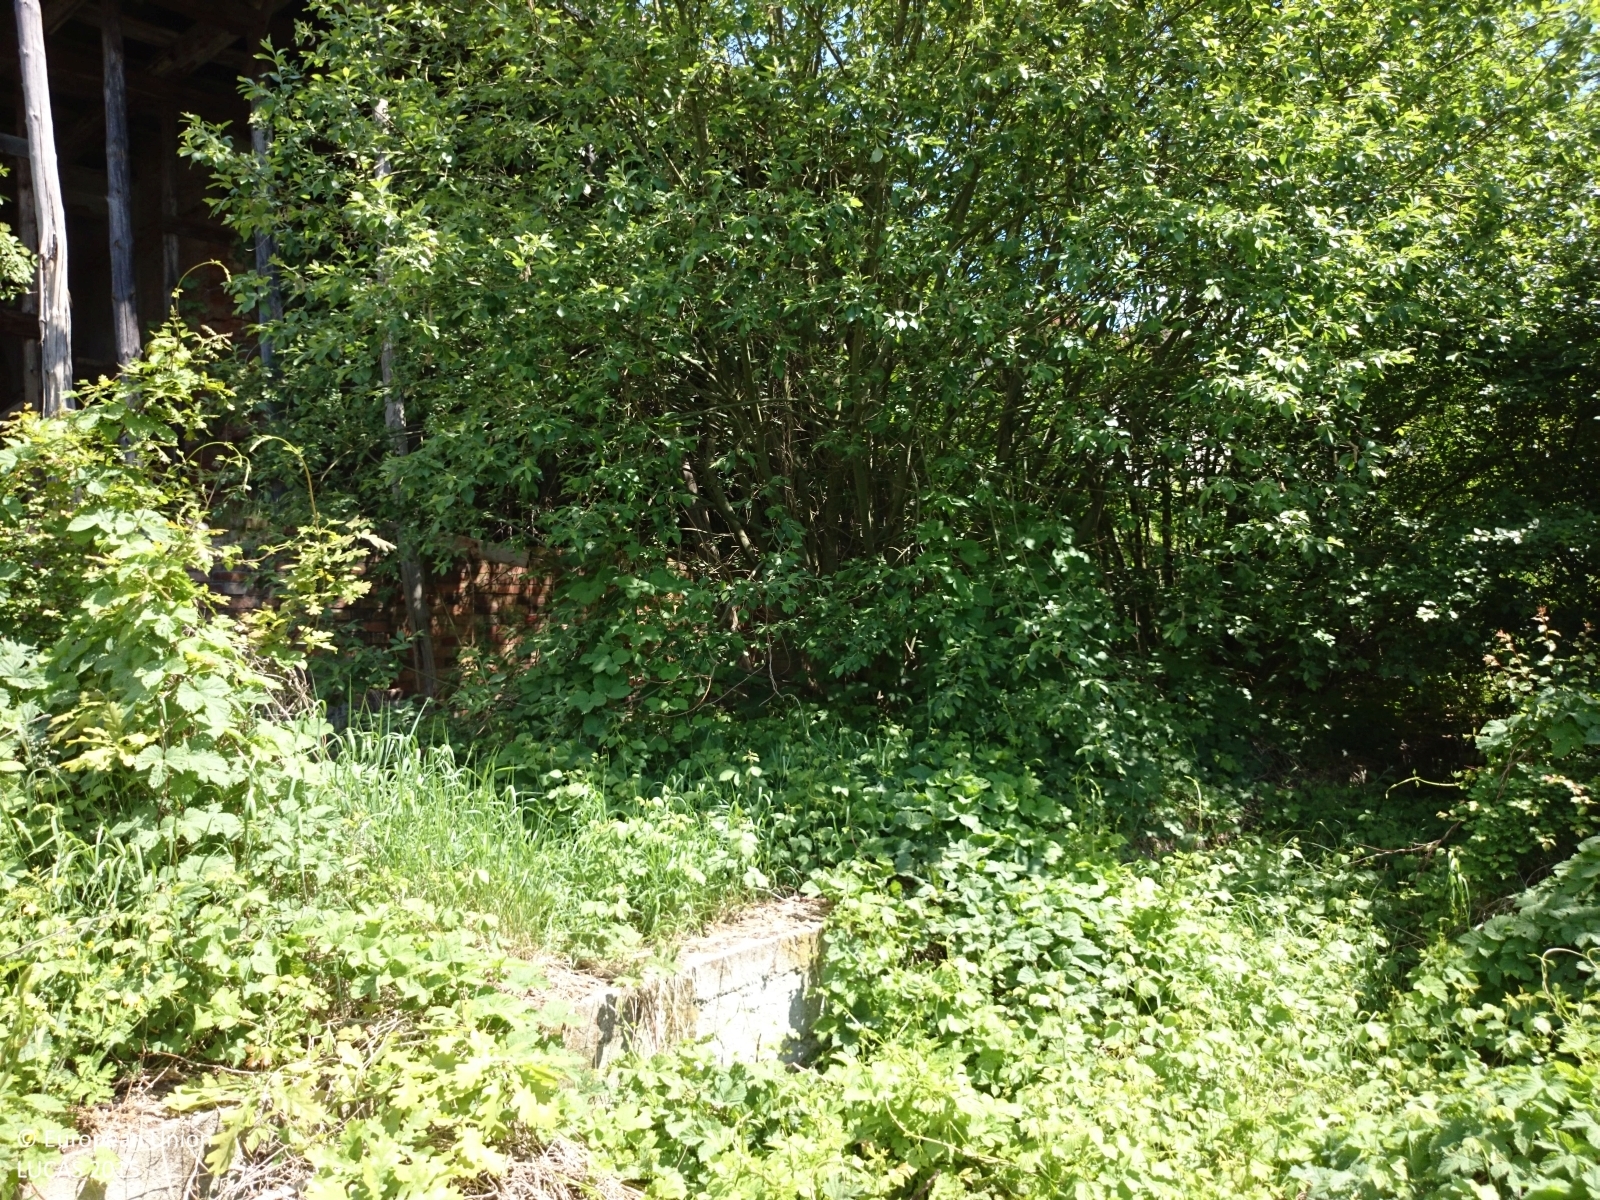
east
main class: Shrubland
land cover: Shrubland with sparse tree cover
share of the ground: > 75 %
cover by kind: shrubs 85 %, herbaceous plants 10 %, broadleaved forest trees 5 %
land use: Abandoned areas
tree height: > 5 m
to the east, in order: Shrubland with sparse tree cover; Artificial constructions in urban areas; Grassland without tree/shrub cover
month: May
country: PL
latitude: 52.4417
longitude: 15.6388
